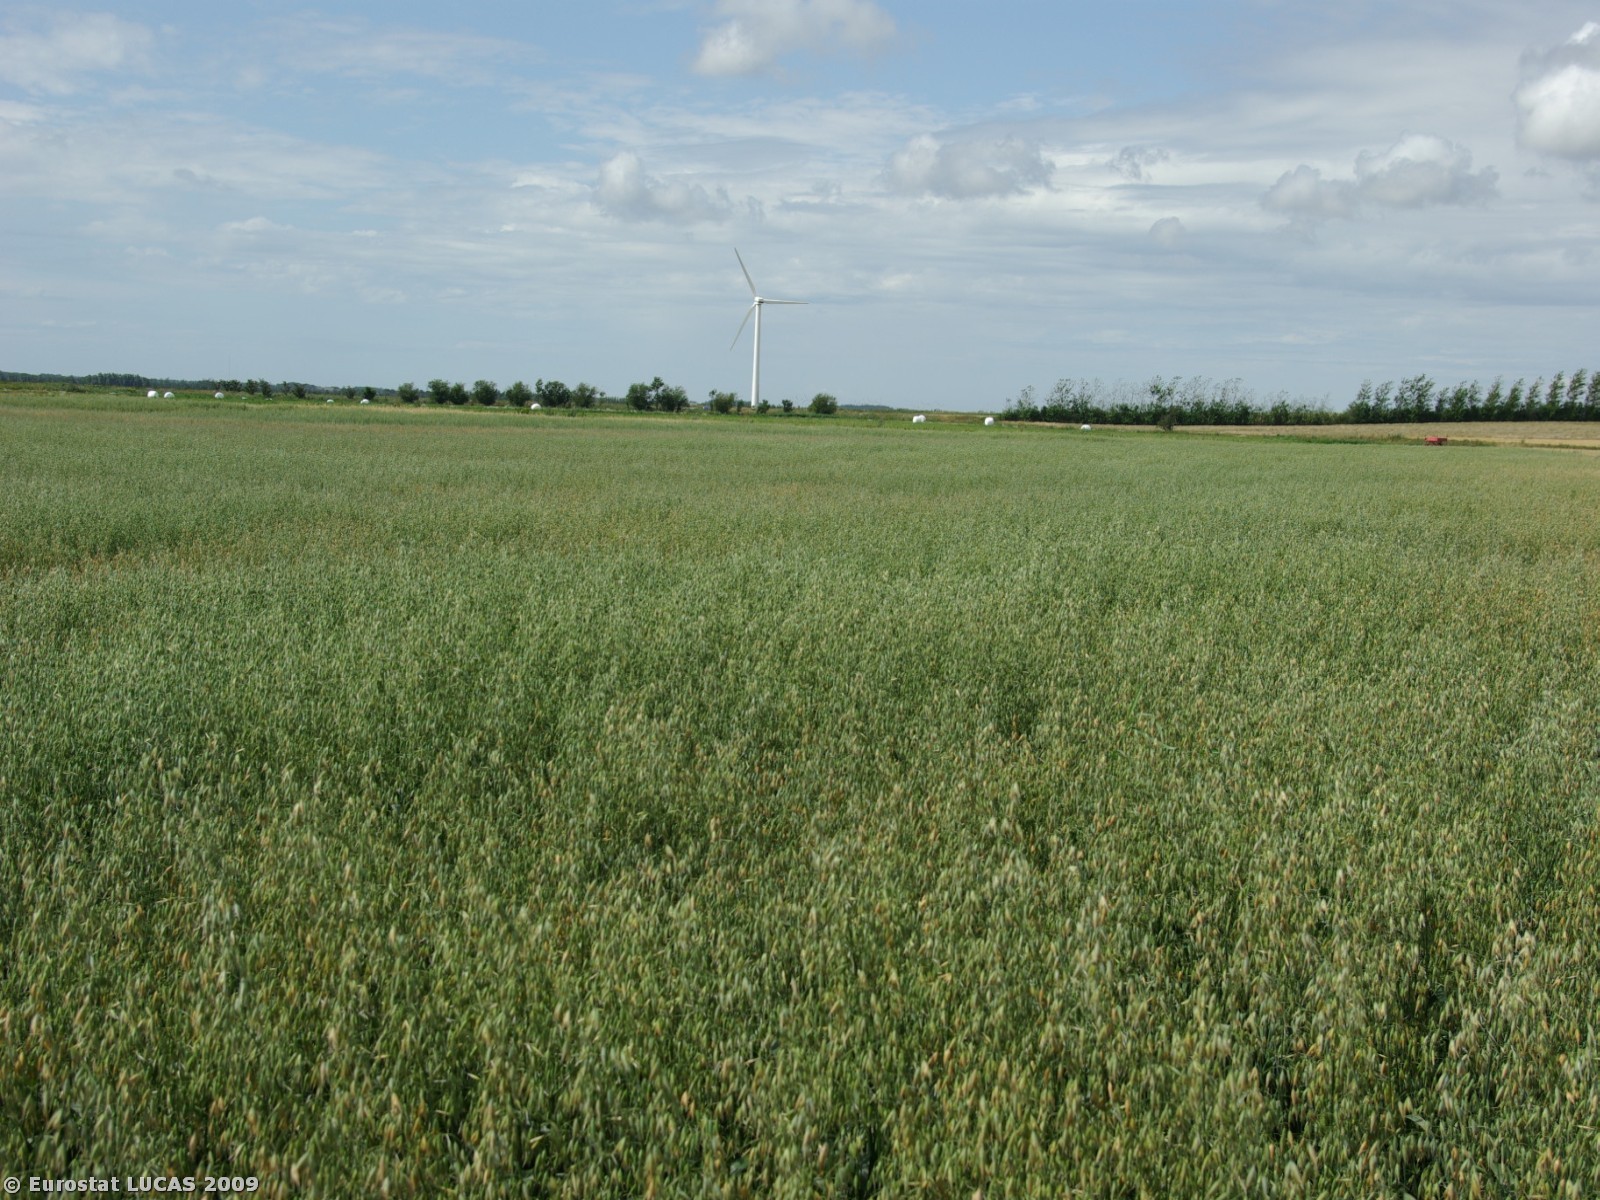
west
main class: Cropland
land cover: Oats
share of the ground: > 75 %
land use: Agriculture (excluding fallow land and kitchen gardens)
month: July
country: DK
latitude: 55.0316
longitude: 8.7962
